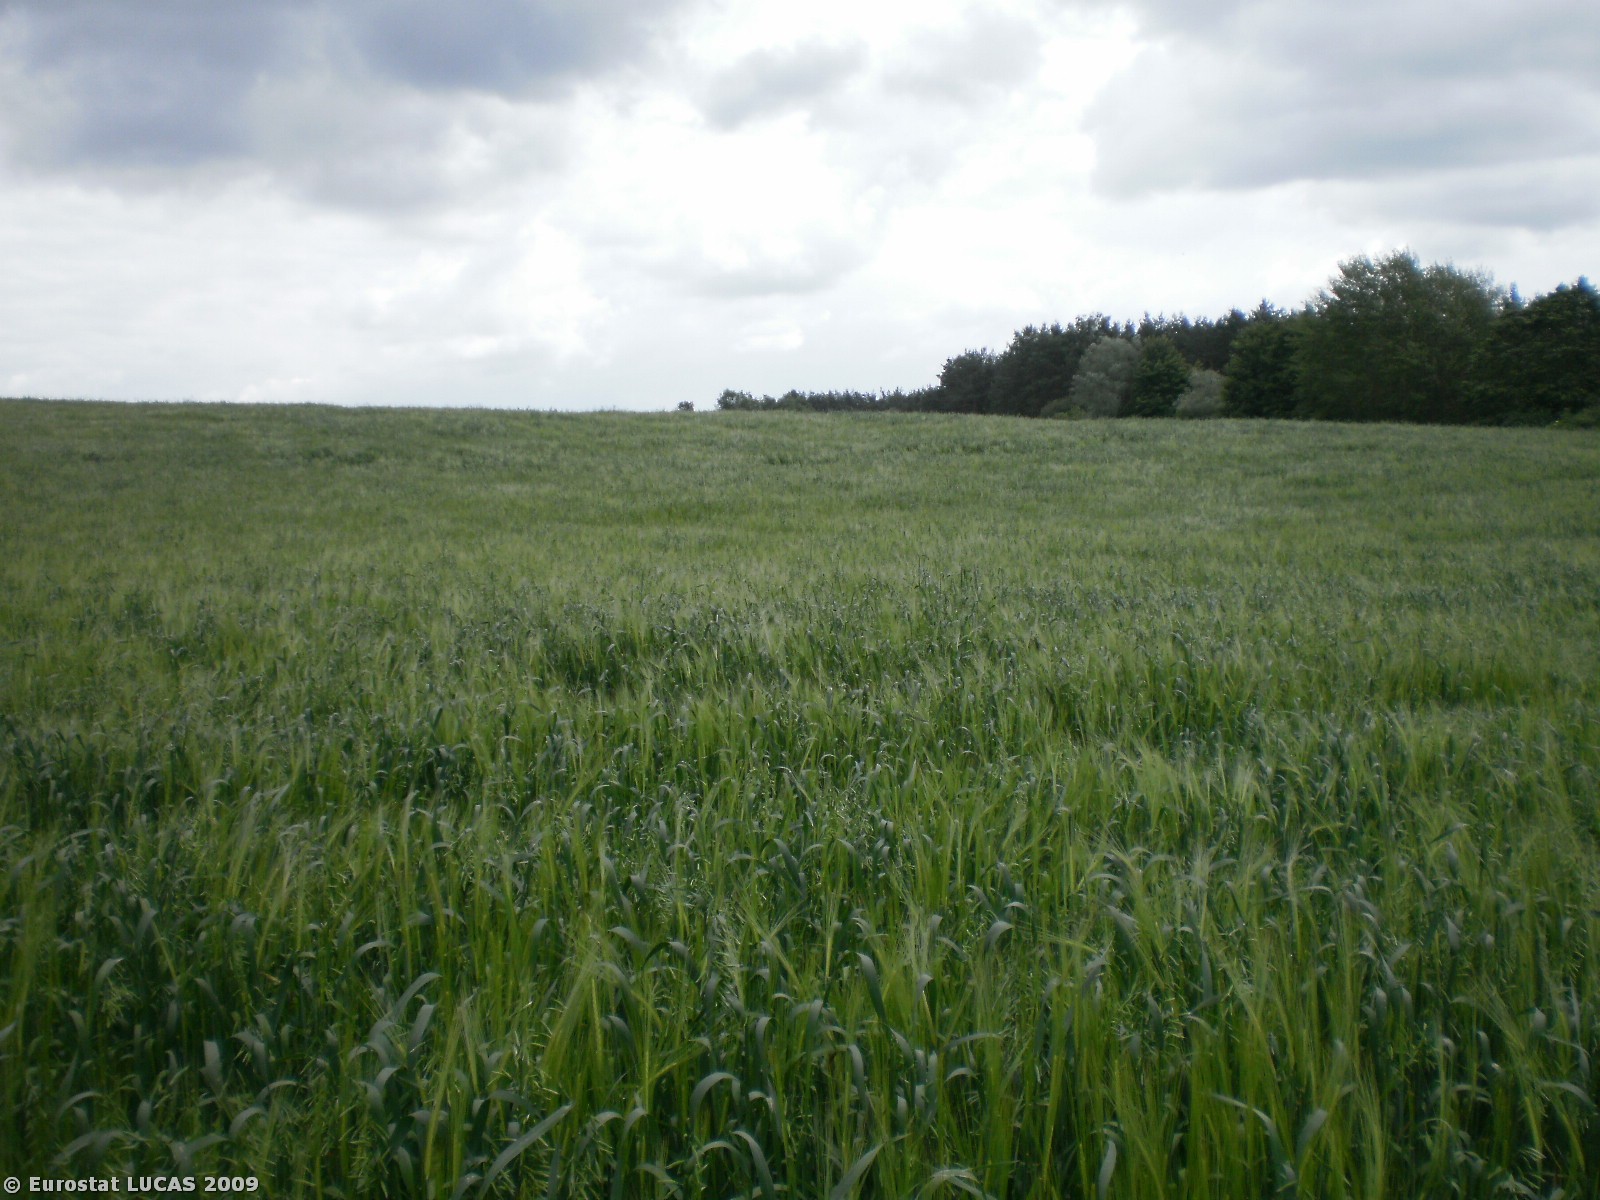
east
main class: Cropland
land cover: Mixed cereals for fodder
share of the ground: > 75 %
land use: Agriculture (excluding fallow land and kitchen gardens)
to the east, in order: Mixed cereals for fodder; Triticale
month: June
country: PL
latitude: 53.4383
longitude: 19.7995
